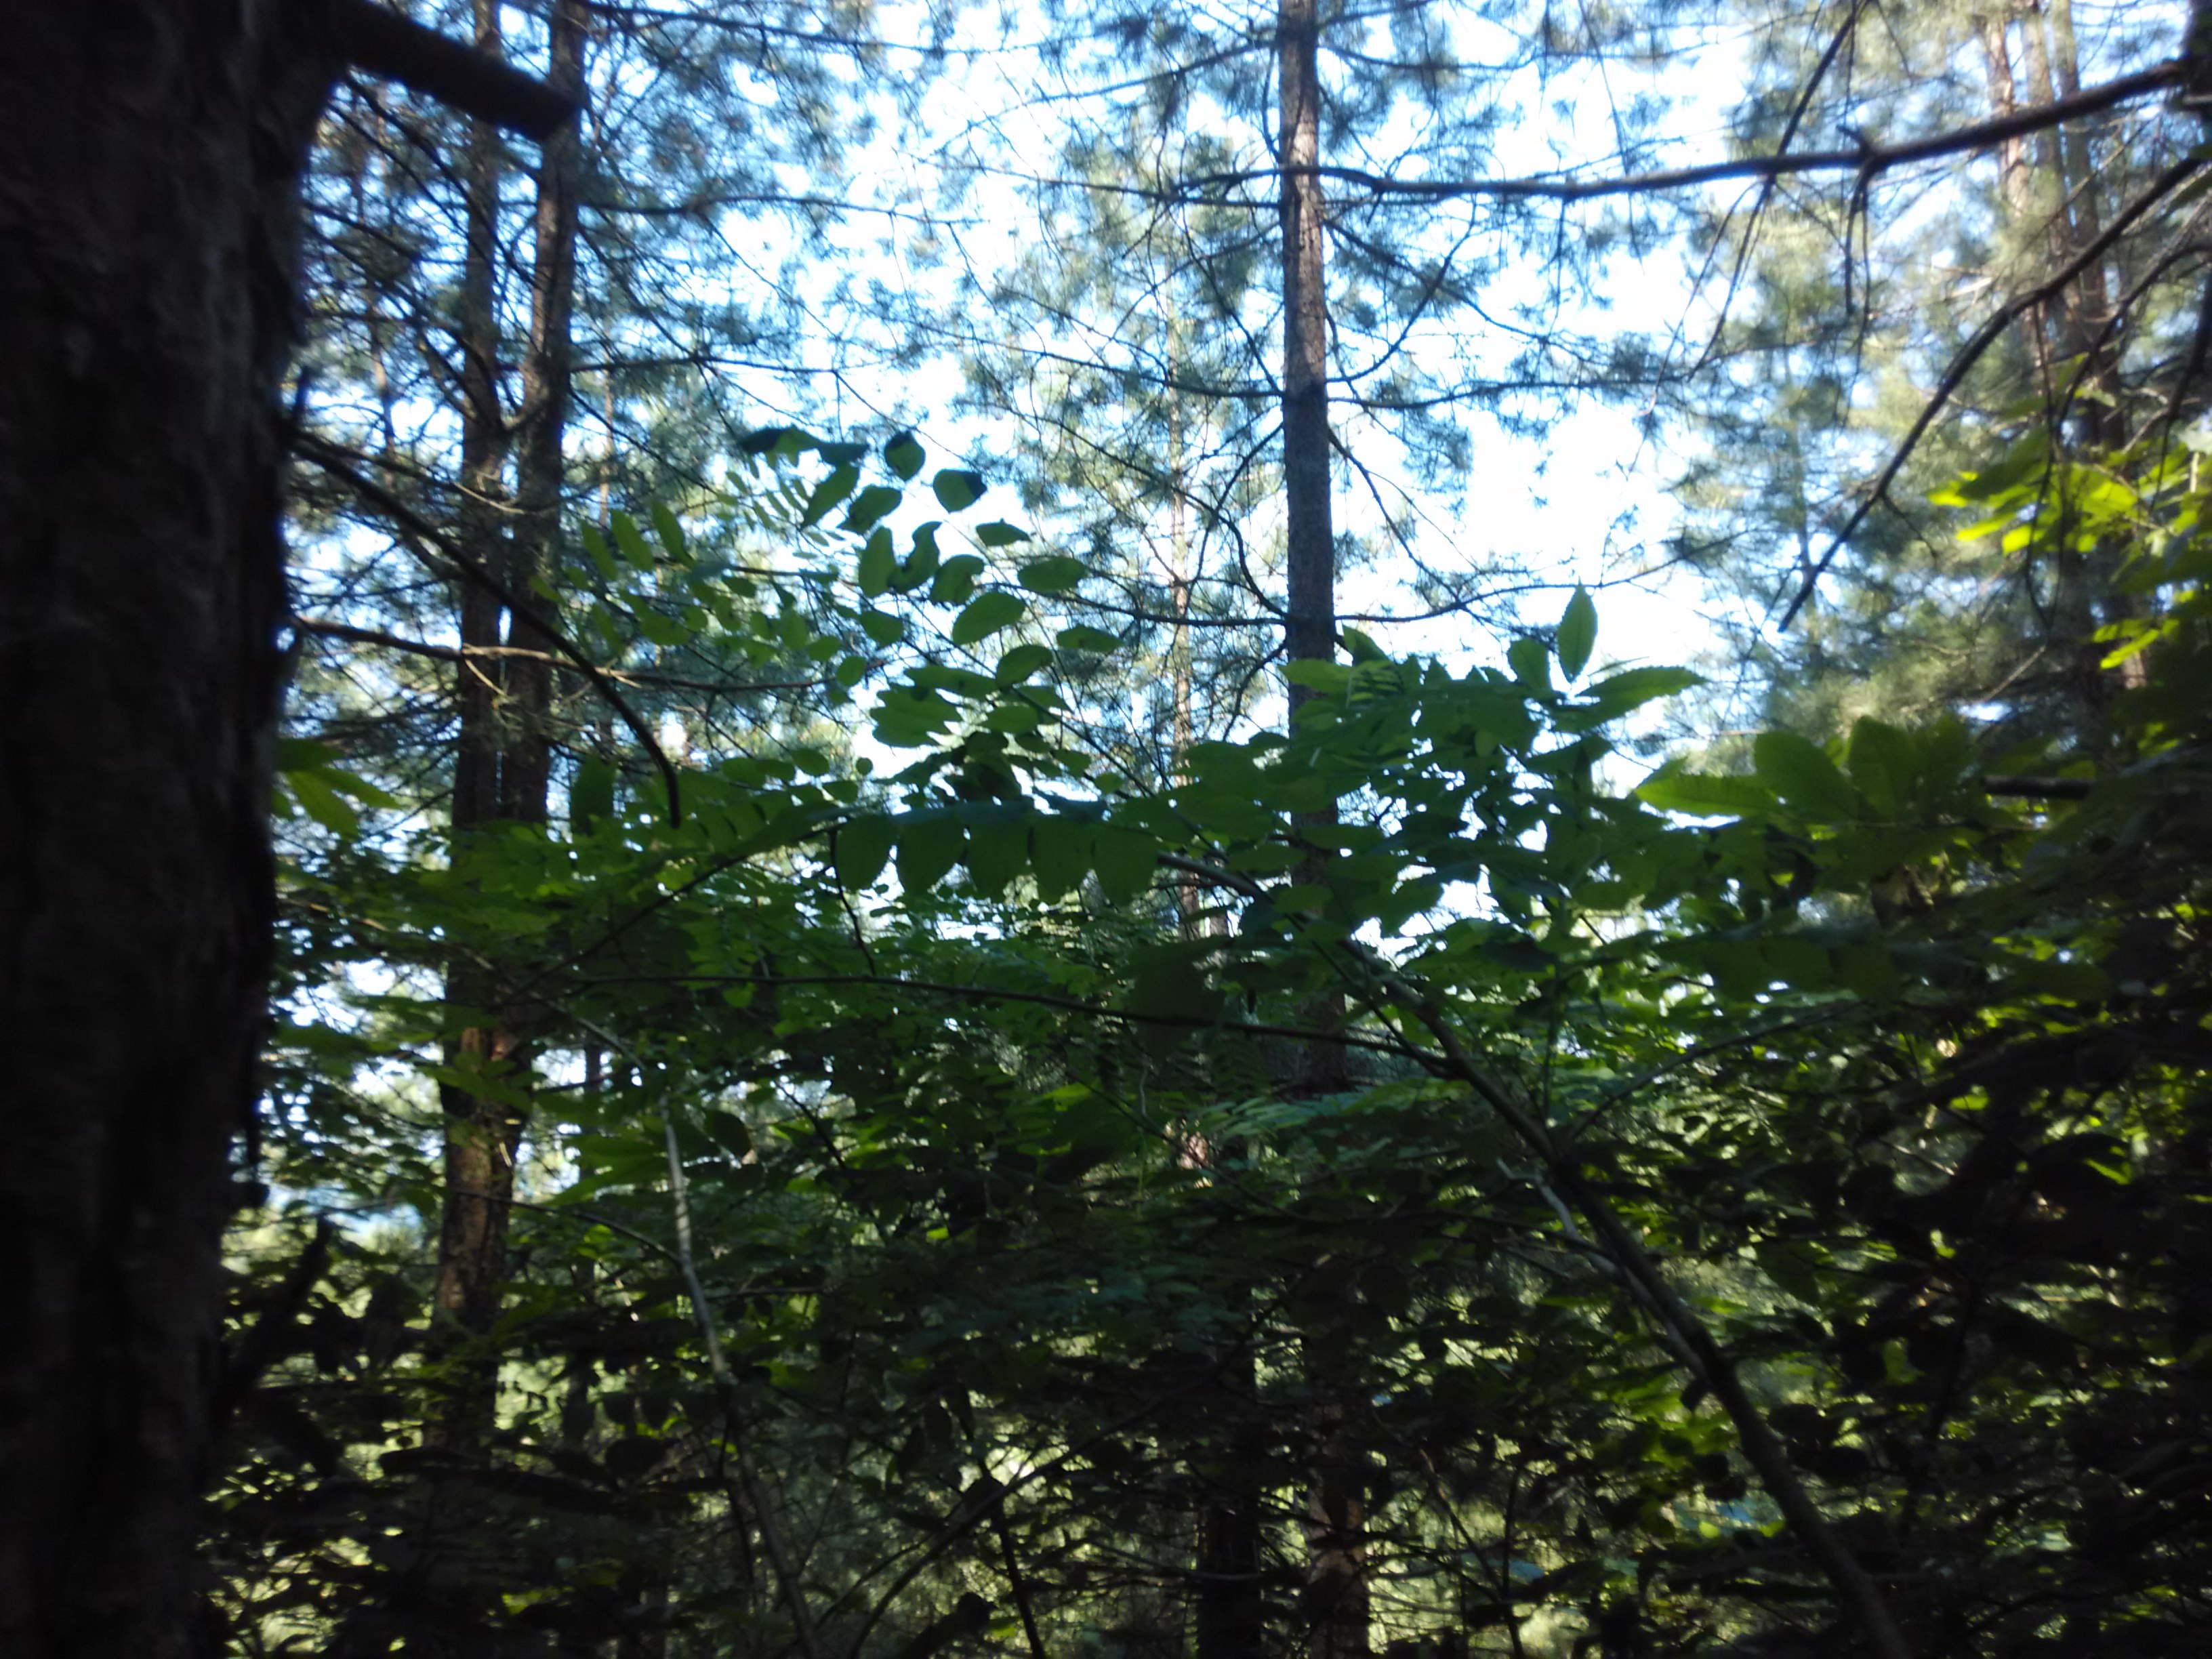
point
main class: Woodland
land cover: Pine dominated mixed woodland
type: exotic forest
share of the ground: > 75 %
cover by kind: coniferous forest trees 70 %, broadleaved forest trees 30 %
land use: Forestry
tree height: > 5 m
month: June
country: ES
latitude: 43.0401
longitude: -2.3856
